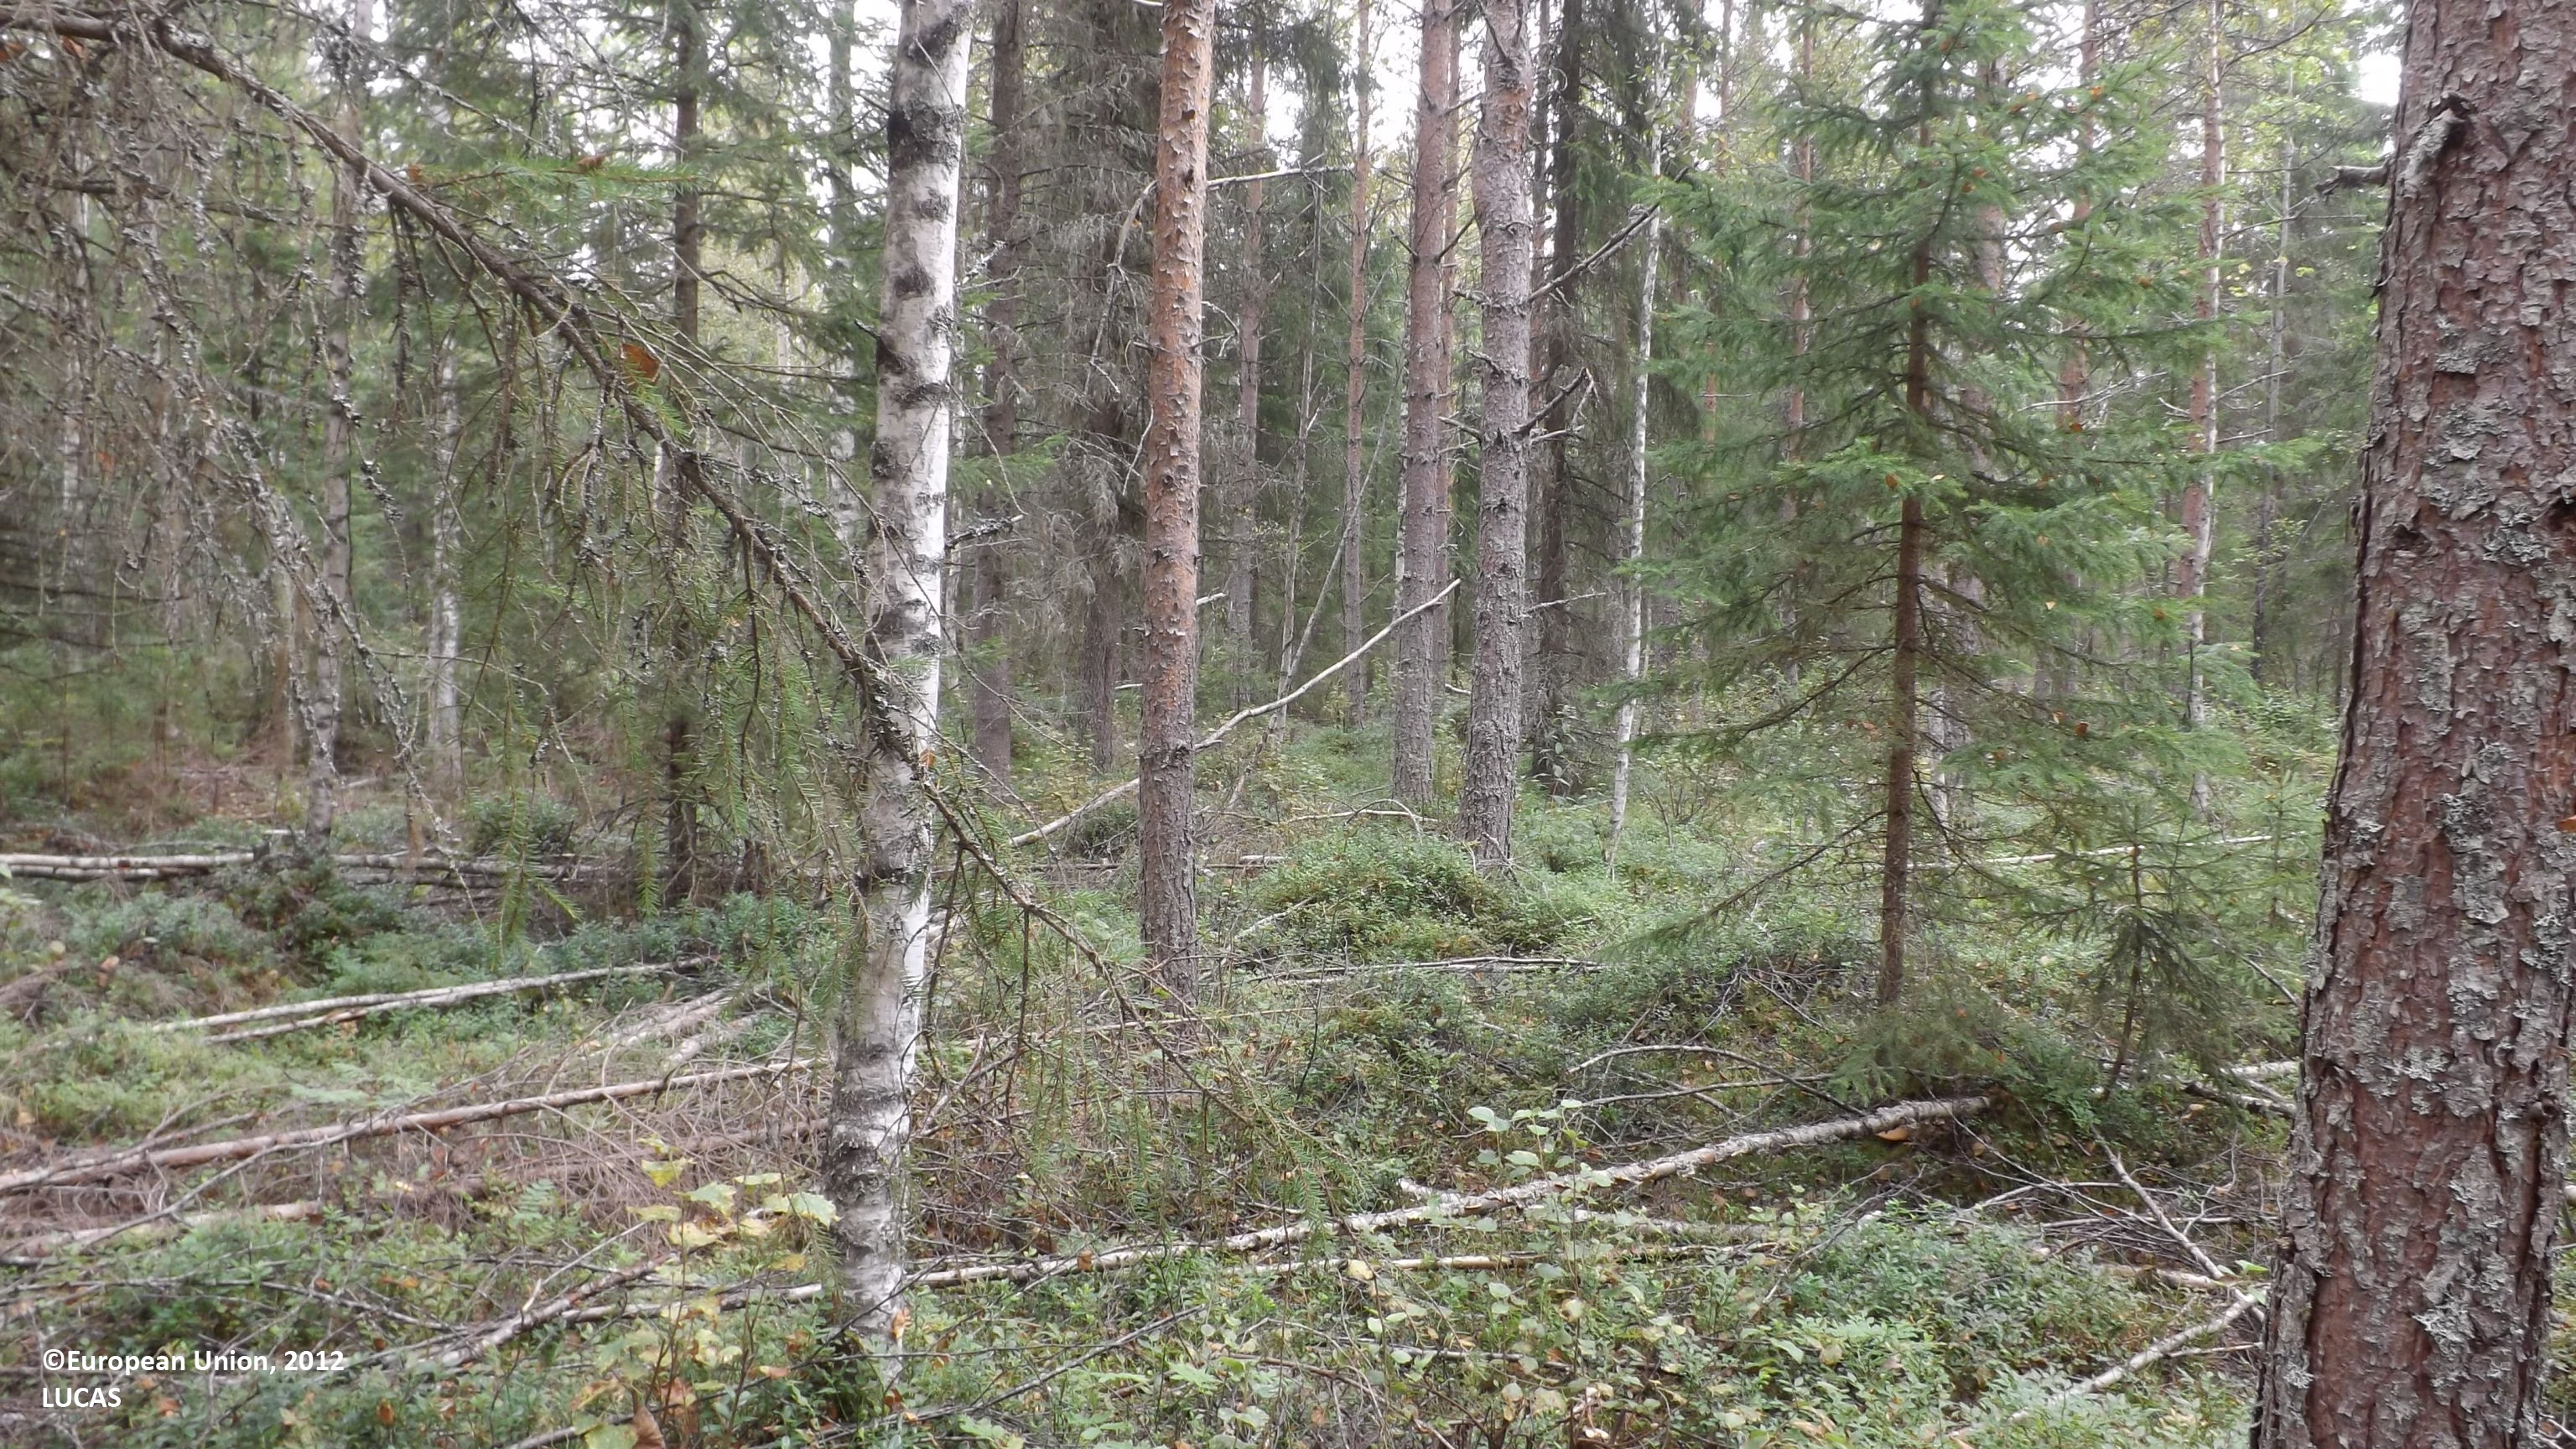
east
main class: Woodland
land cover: Other mixed woodland
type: boreal forest
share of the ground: > 75 %
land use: Forestry
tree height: > 5 m
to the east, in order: Other mixed woodland; Spruce dominated mixed woodland; Shrubland with sparse tree cover; Ditches and canals; Spruce dominated mixed woodland; Other mixed woodland; Ditches and canals; Spruce dominated mixed woodland; Other mixed woodland; Ditches and canals; Other mixed woodland; Spruce dominated mixed woodland; Ditches and canals; Spruce dominated mixed woodland; Shrubland with sparse tree cover; Other mixed woodland
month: August
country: FI
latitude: 63.8683
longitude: 24.1725
